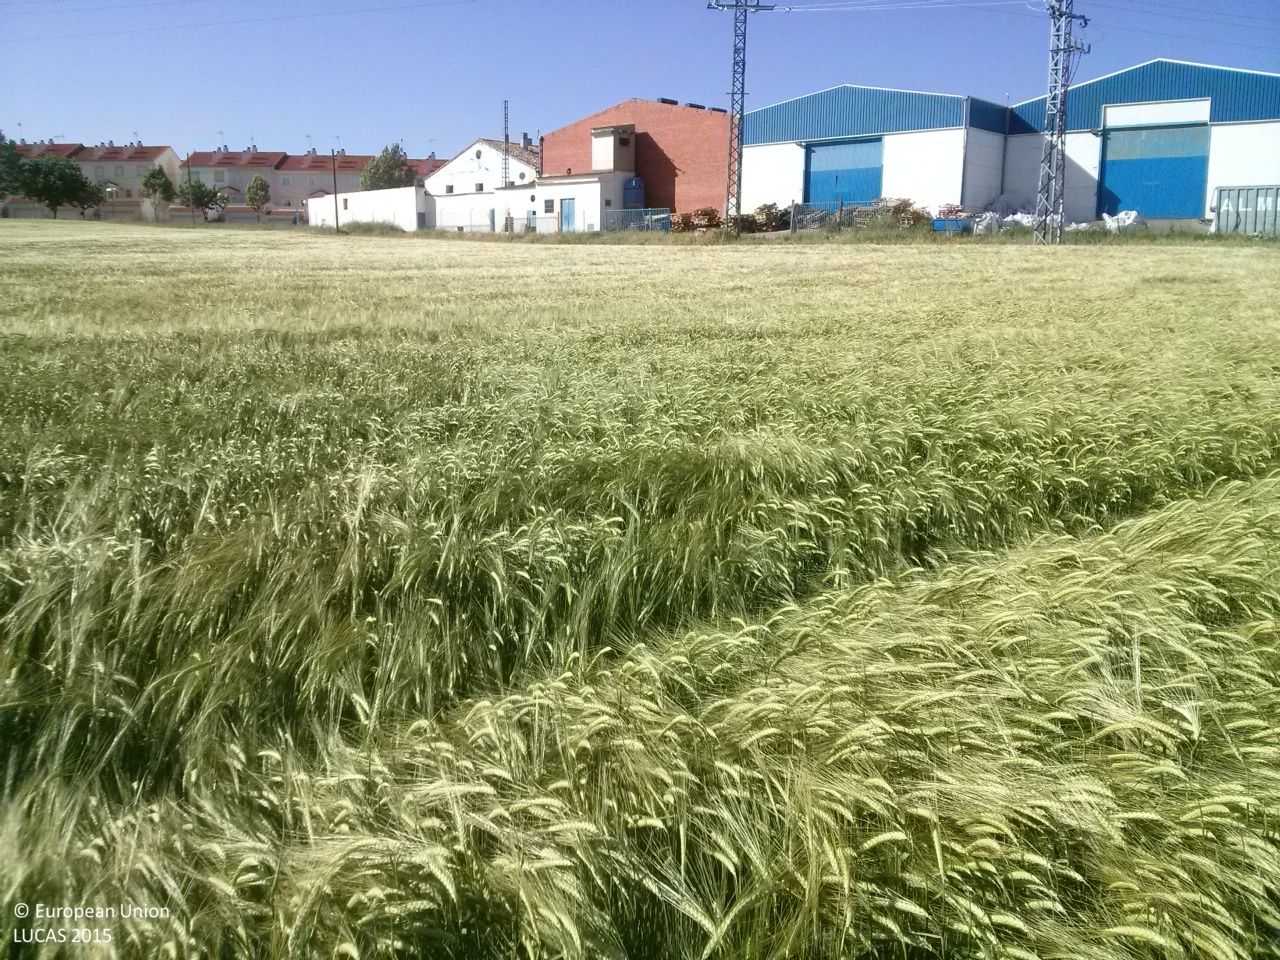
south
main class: Cropland
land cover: Barley
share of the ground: > 75 %
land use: Agriculture (excluding fallow land and kitchen gardens)
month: May
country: ES
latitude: 40.0637
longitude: -2.8134
